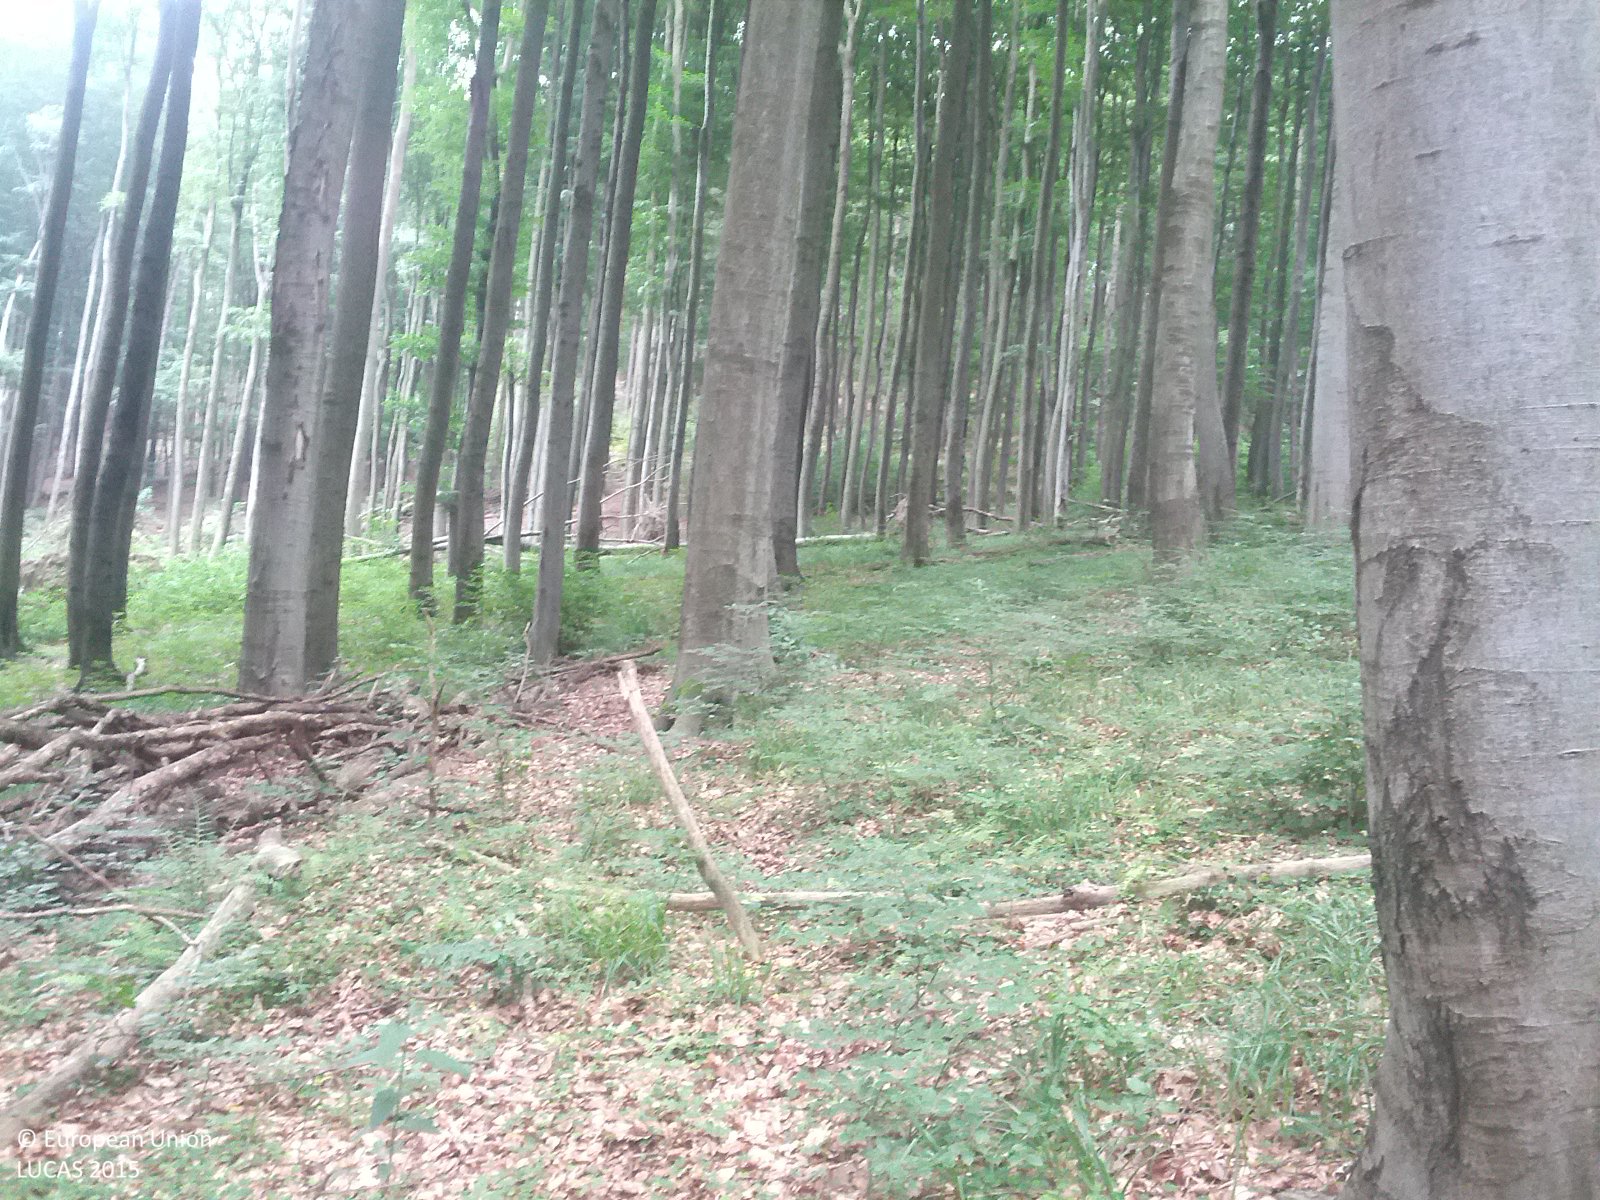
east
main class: Woodland
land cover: Broadleaved woodland
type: beech forest
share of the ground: > 75 %
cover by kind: broadleaved forest trees 65 %, herbaceous plants 30 %, shrubs 5 %
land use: Forestry
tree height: > 5 m
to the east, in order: Broadleaved woodland; Spruce dominated mixed woodland
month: June
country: AT
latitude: 48.2185
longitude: 16.0742
